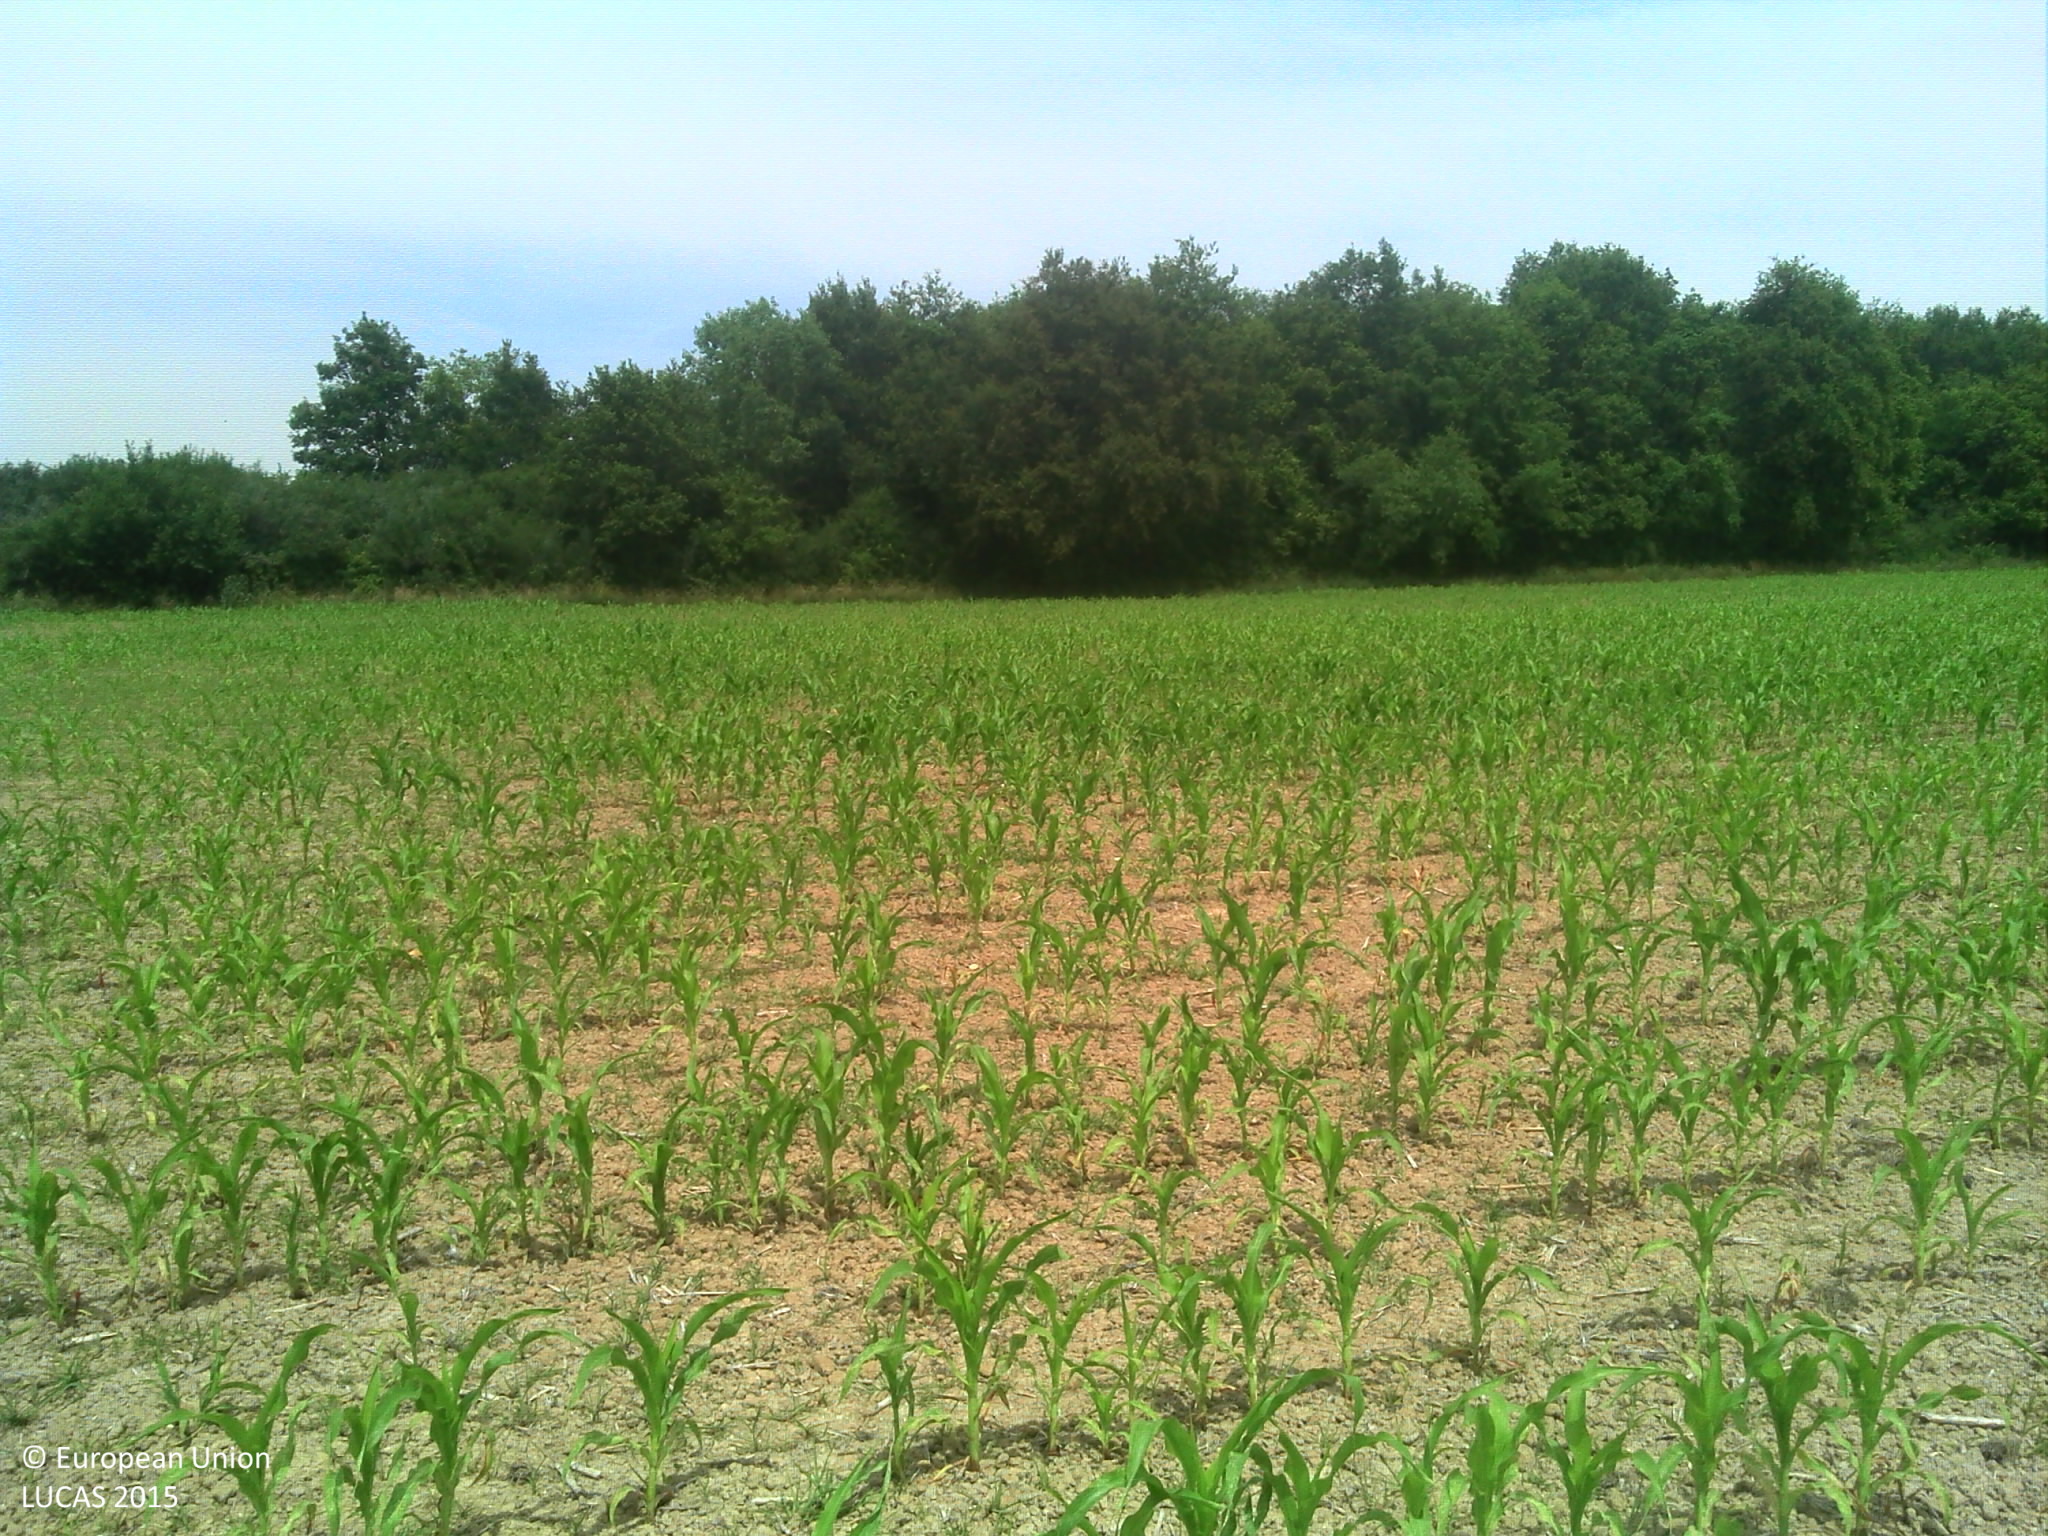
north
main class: Cropland
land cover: Maize
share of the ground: 25 - 50 %
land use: Agriculture (excluding fallow land and kitchen gardens)
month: June
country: FR
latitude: 47.4667
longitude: 1.3485
